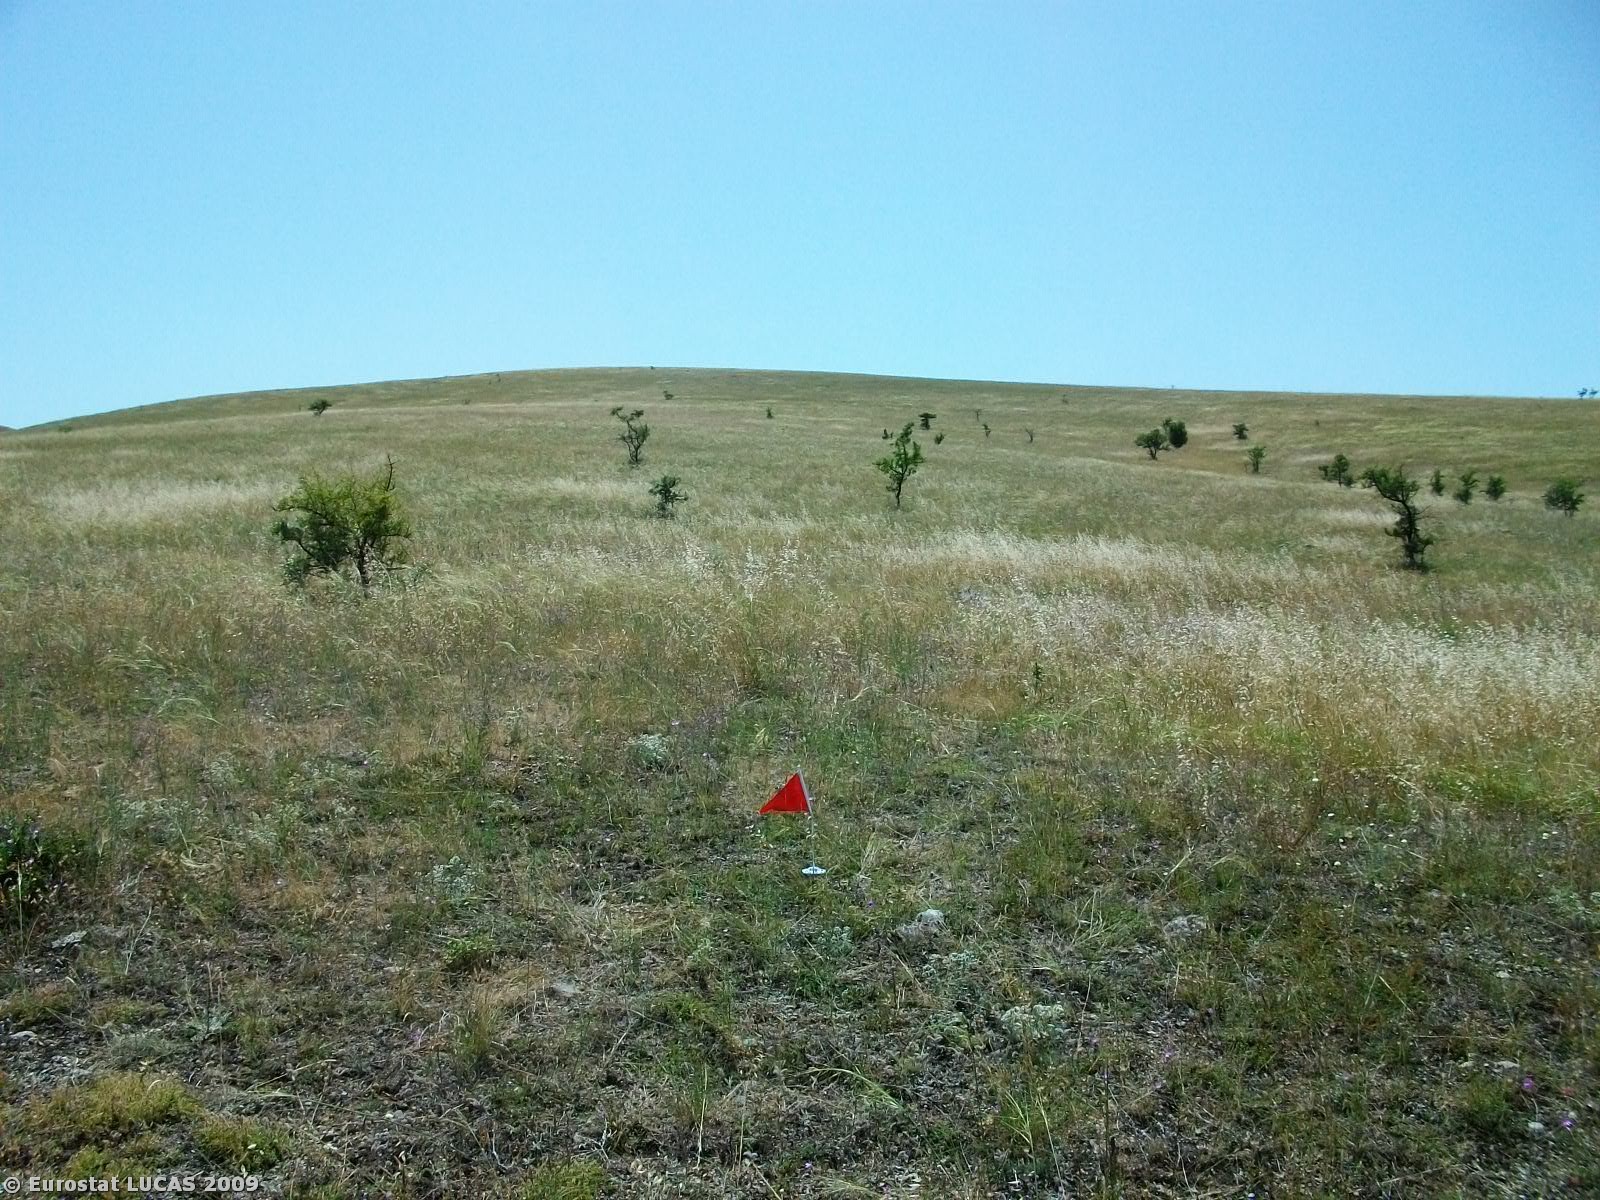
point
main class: Grassland
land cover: Grassland without tree/shrub cover
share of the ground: > 75 %
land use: Unused
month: July
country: GR
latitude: 40.3436
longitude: 21.7527
